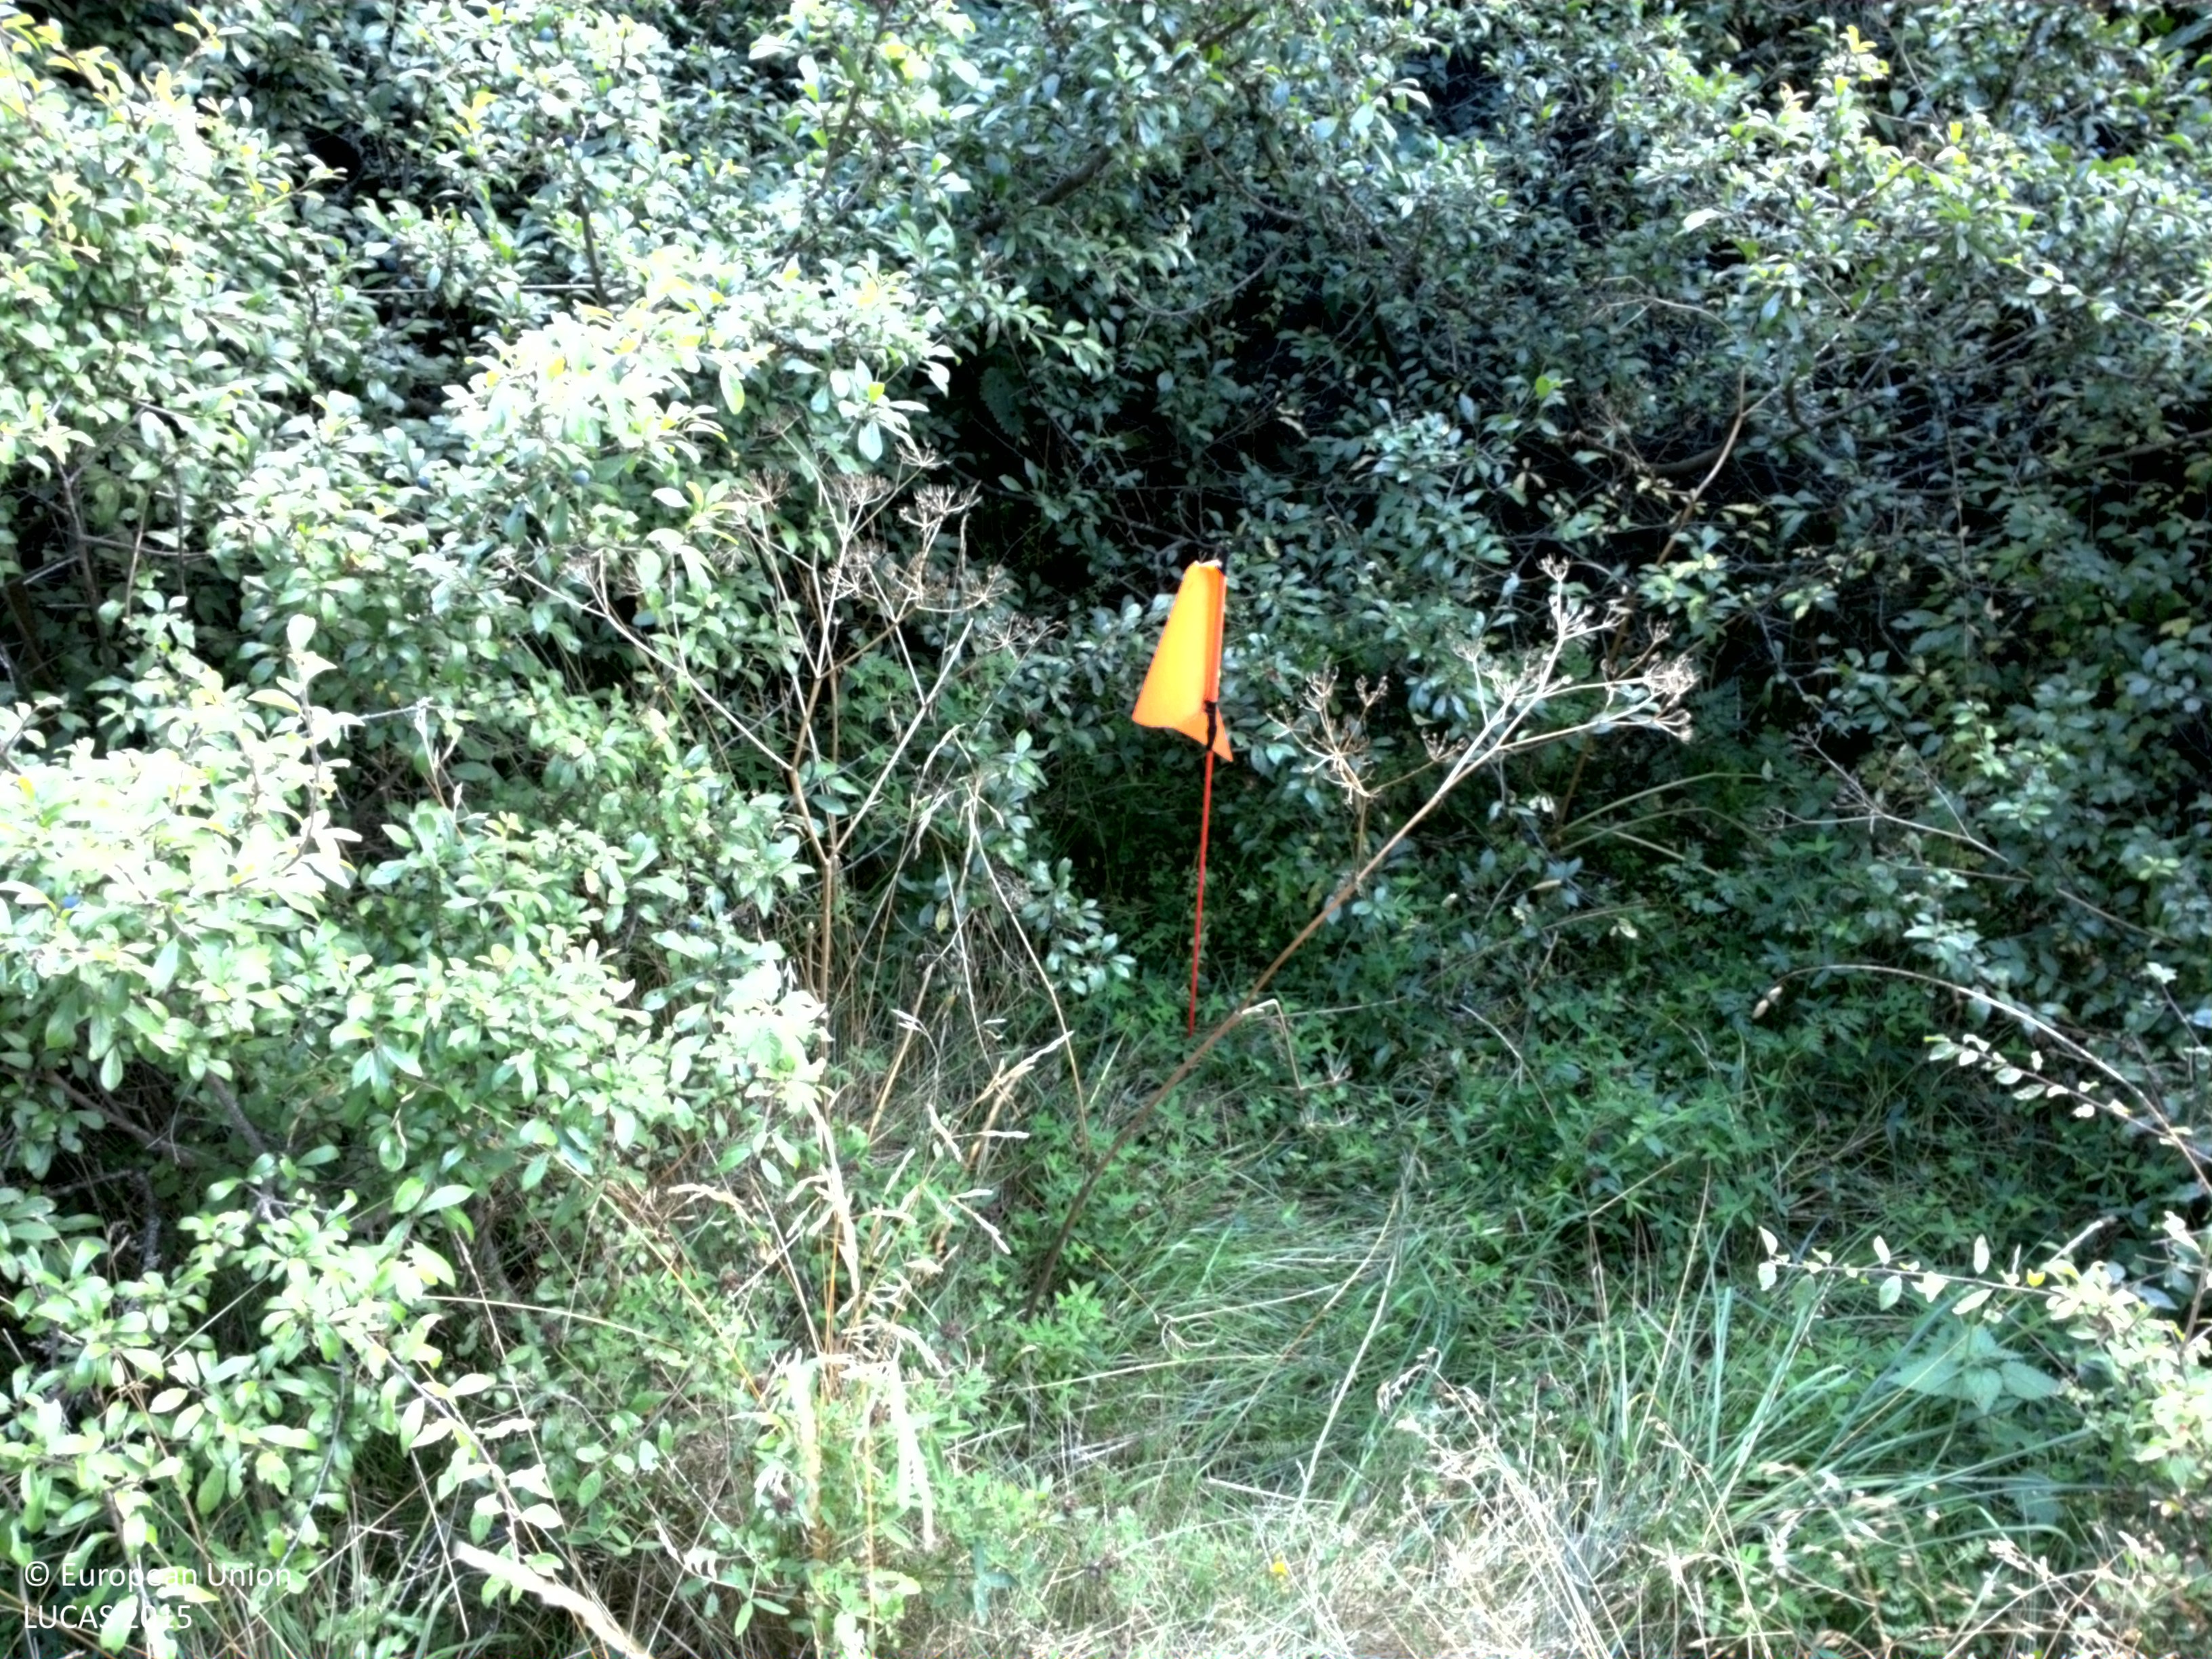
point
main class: Shrubland
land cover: Shrubland with sparse tree cover
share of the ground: > 75 %
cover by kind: shrubs 55 %, herbaceous plants 40 %, coniferous forest trees 5 %
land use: Semi-natural and natural areas not in use
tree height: > 5 m
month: August
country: SE
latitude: 59.6202
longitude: 17.1378
